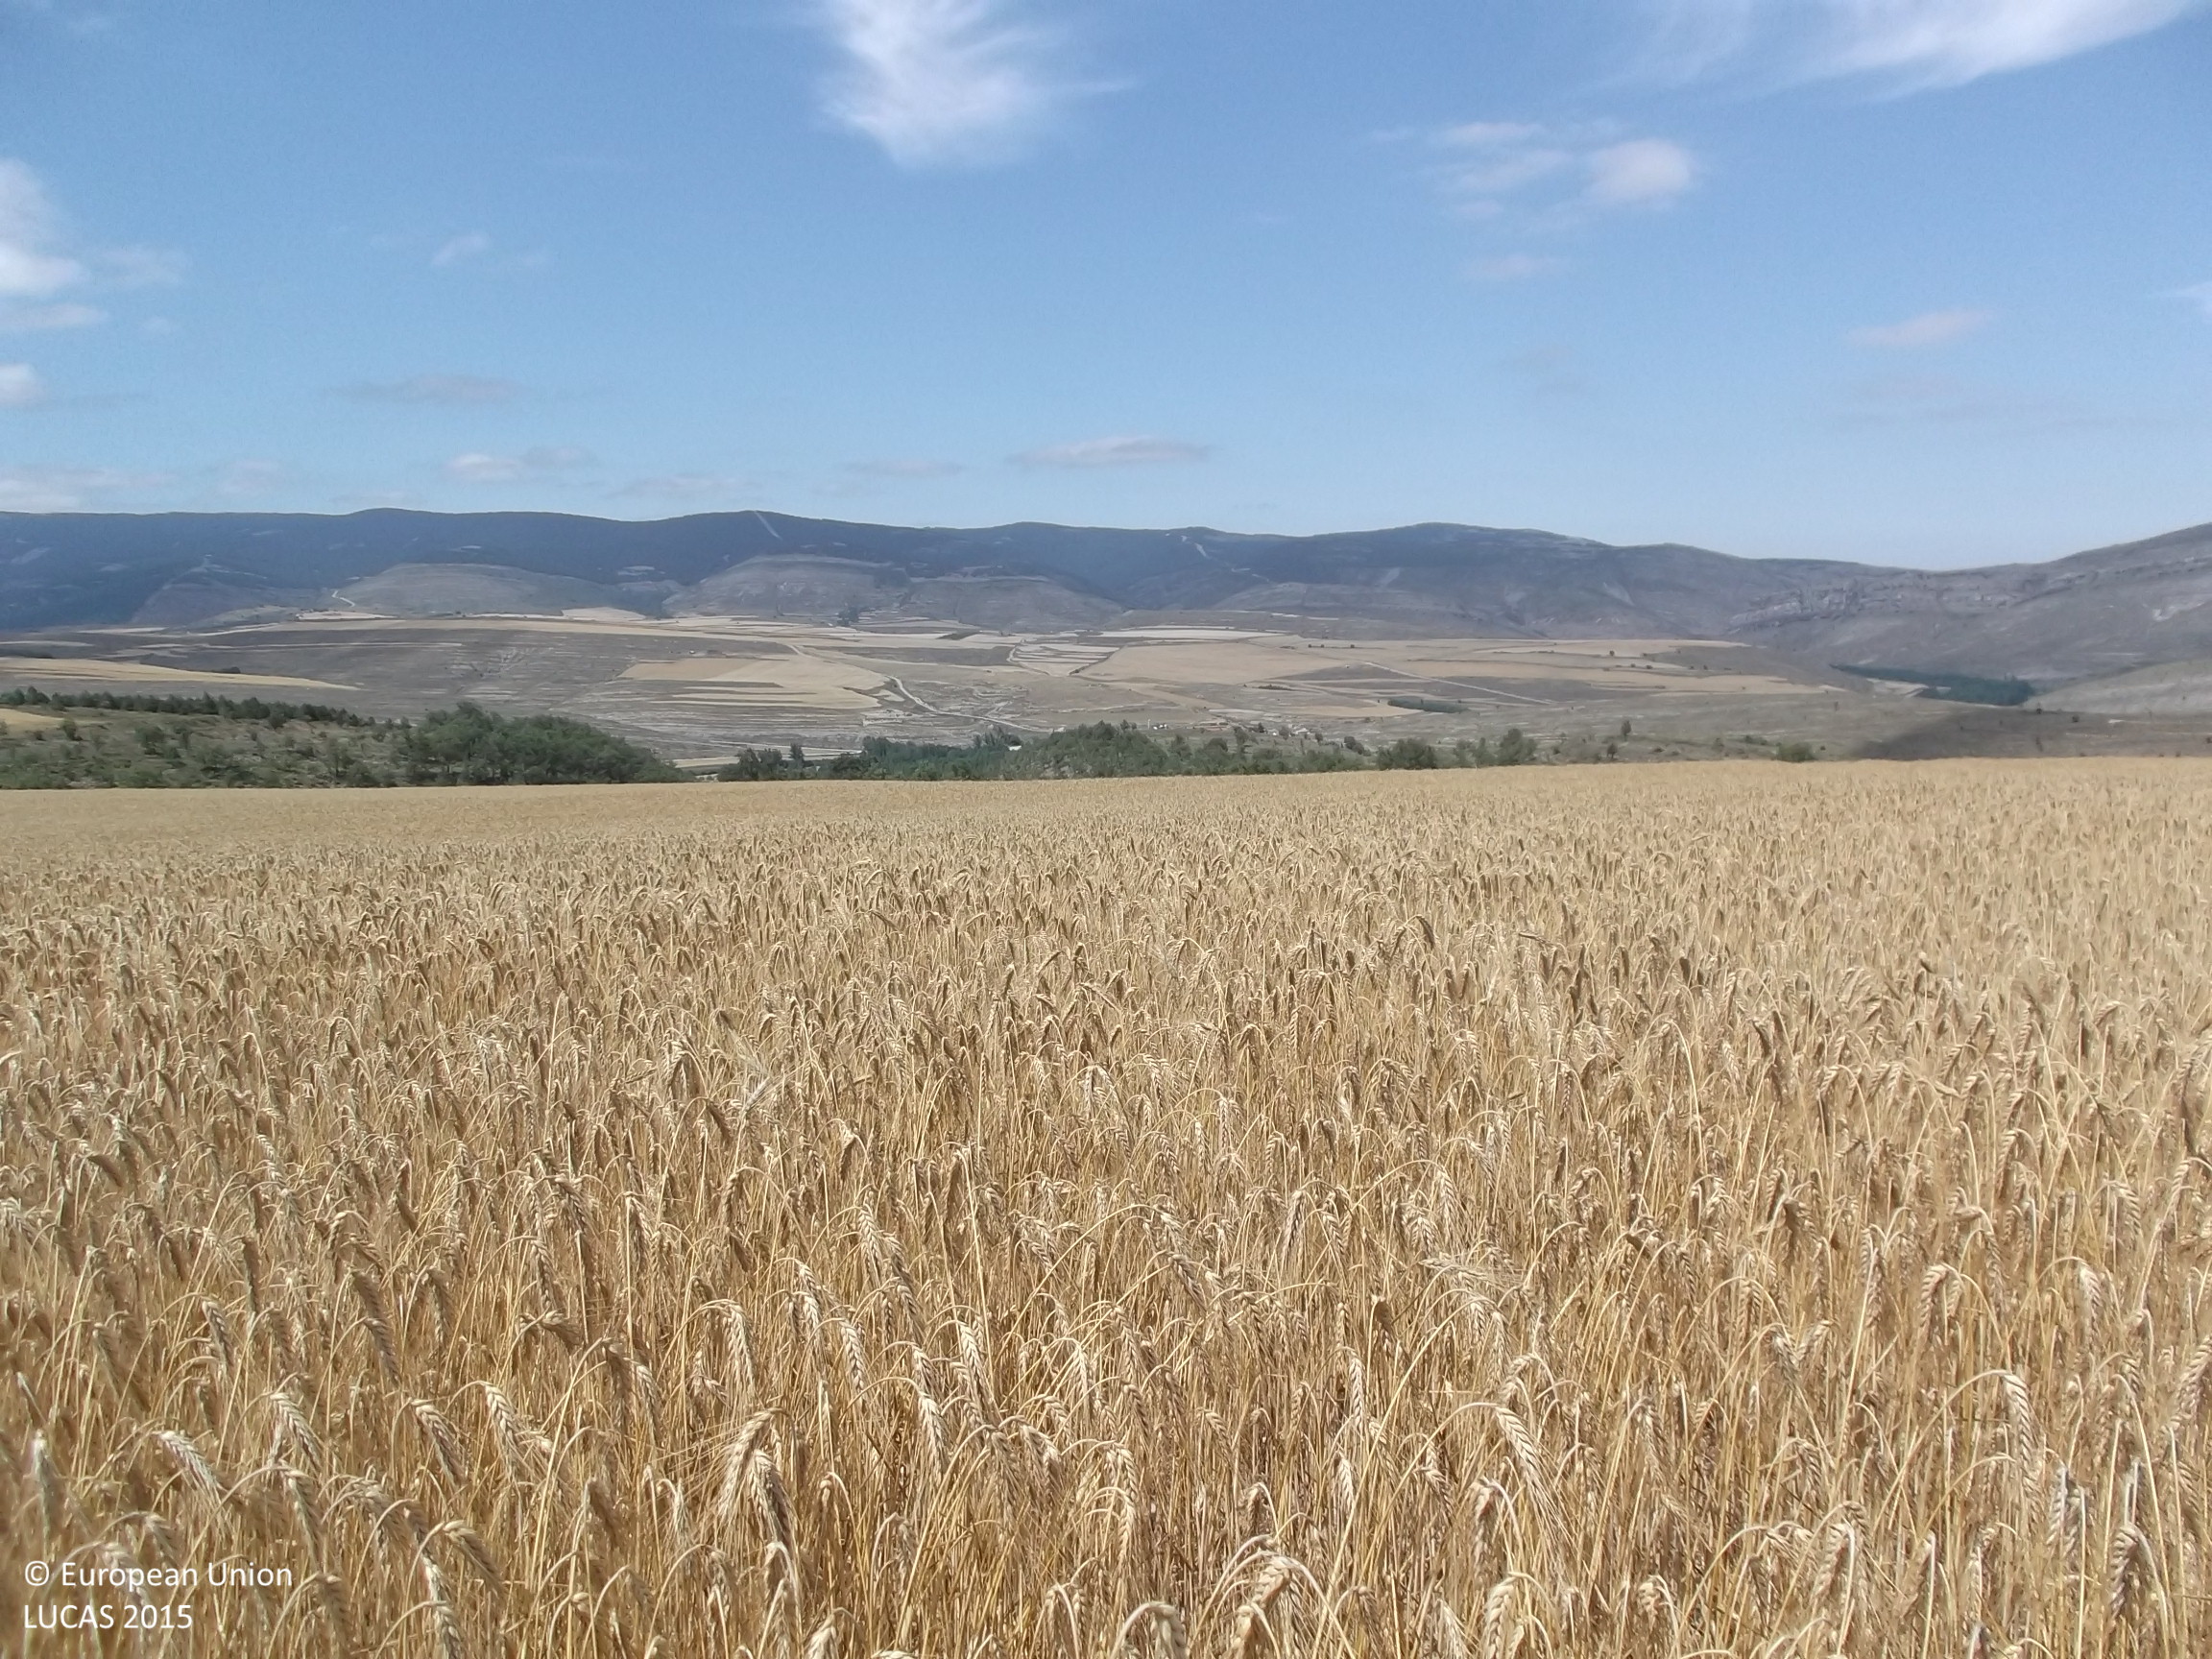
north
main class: Cropland
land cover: Rye
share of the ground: > 75 %
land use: Agriculture (excluding fallow land and kitchen gardens)
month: July
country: ES
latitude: 42.0589
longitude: -2.3532
